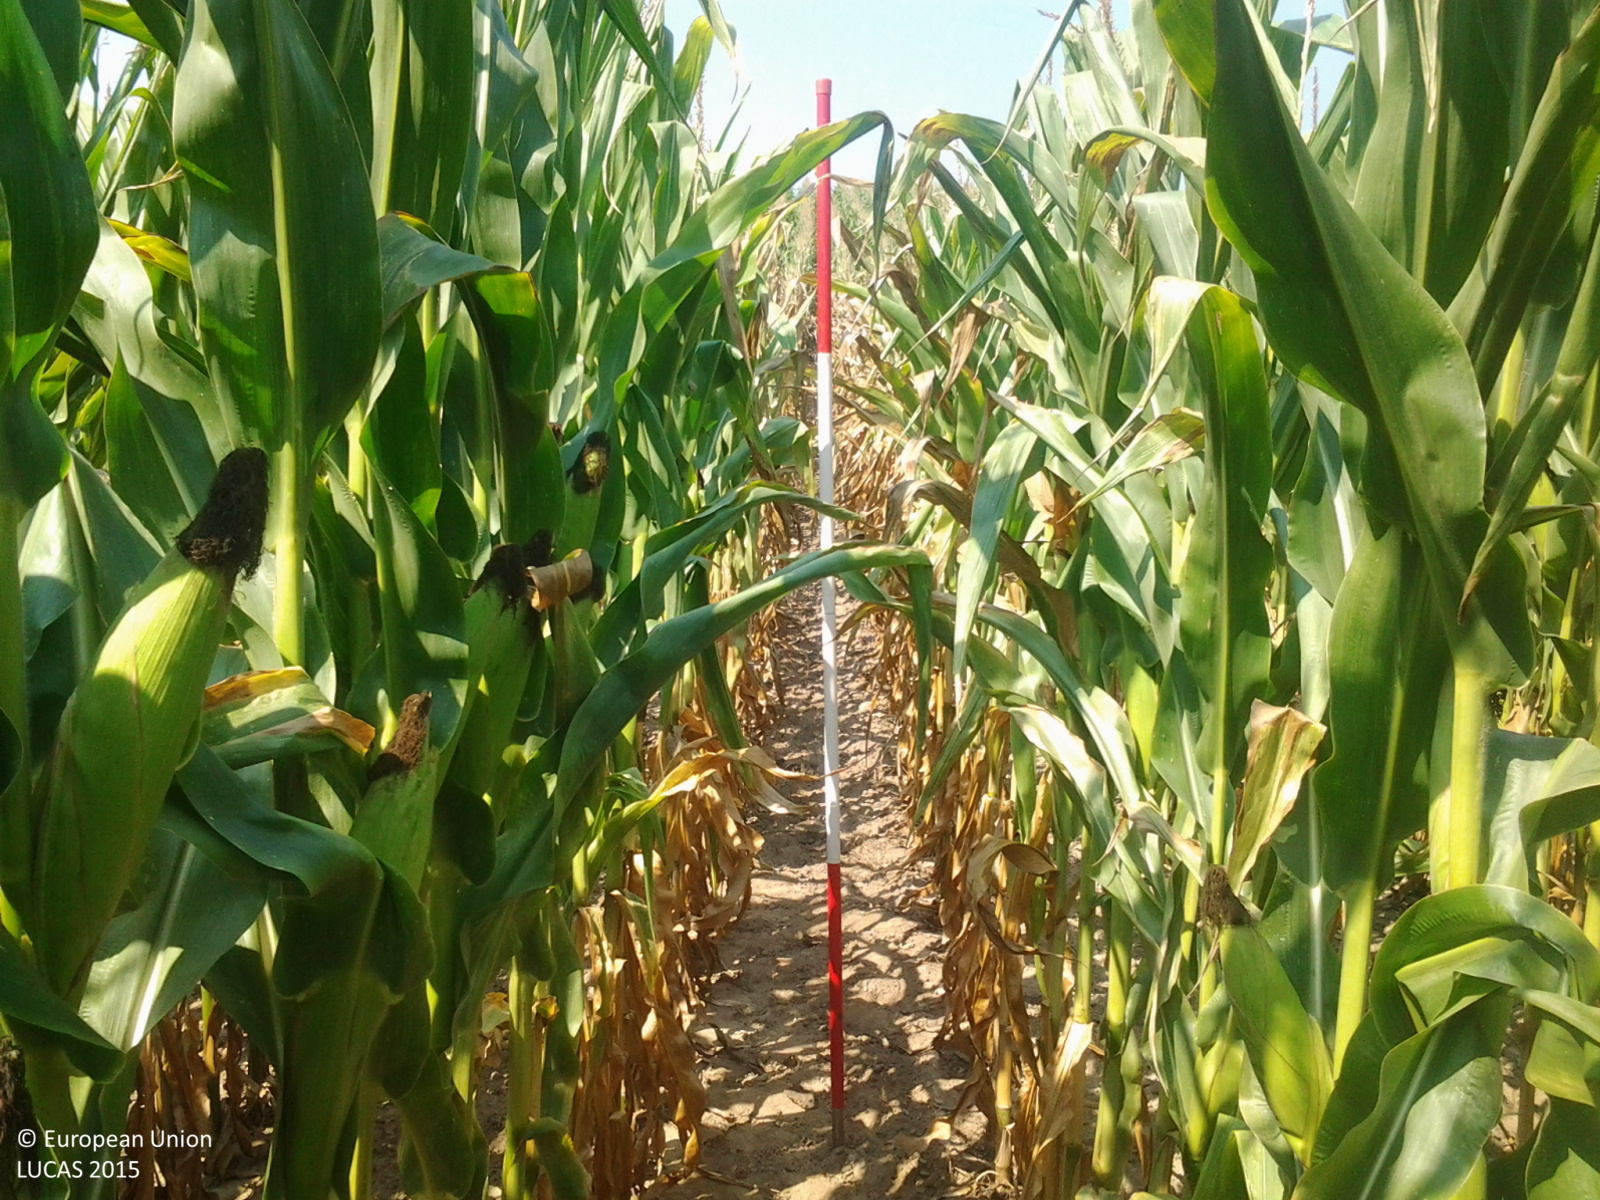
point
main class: Cropland
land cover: Maize
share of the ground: > 75 %
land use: Agriculture (excluding fallow land and kitchen gardens)
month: August
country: HU
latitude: 46.6172
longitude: 18.4067
